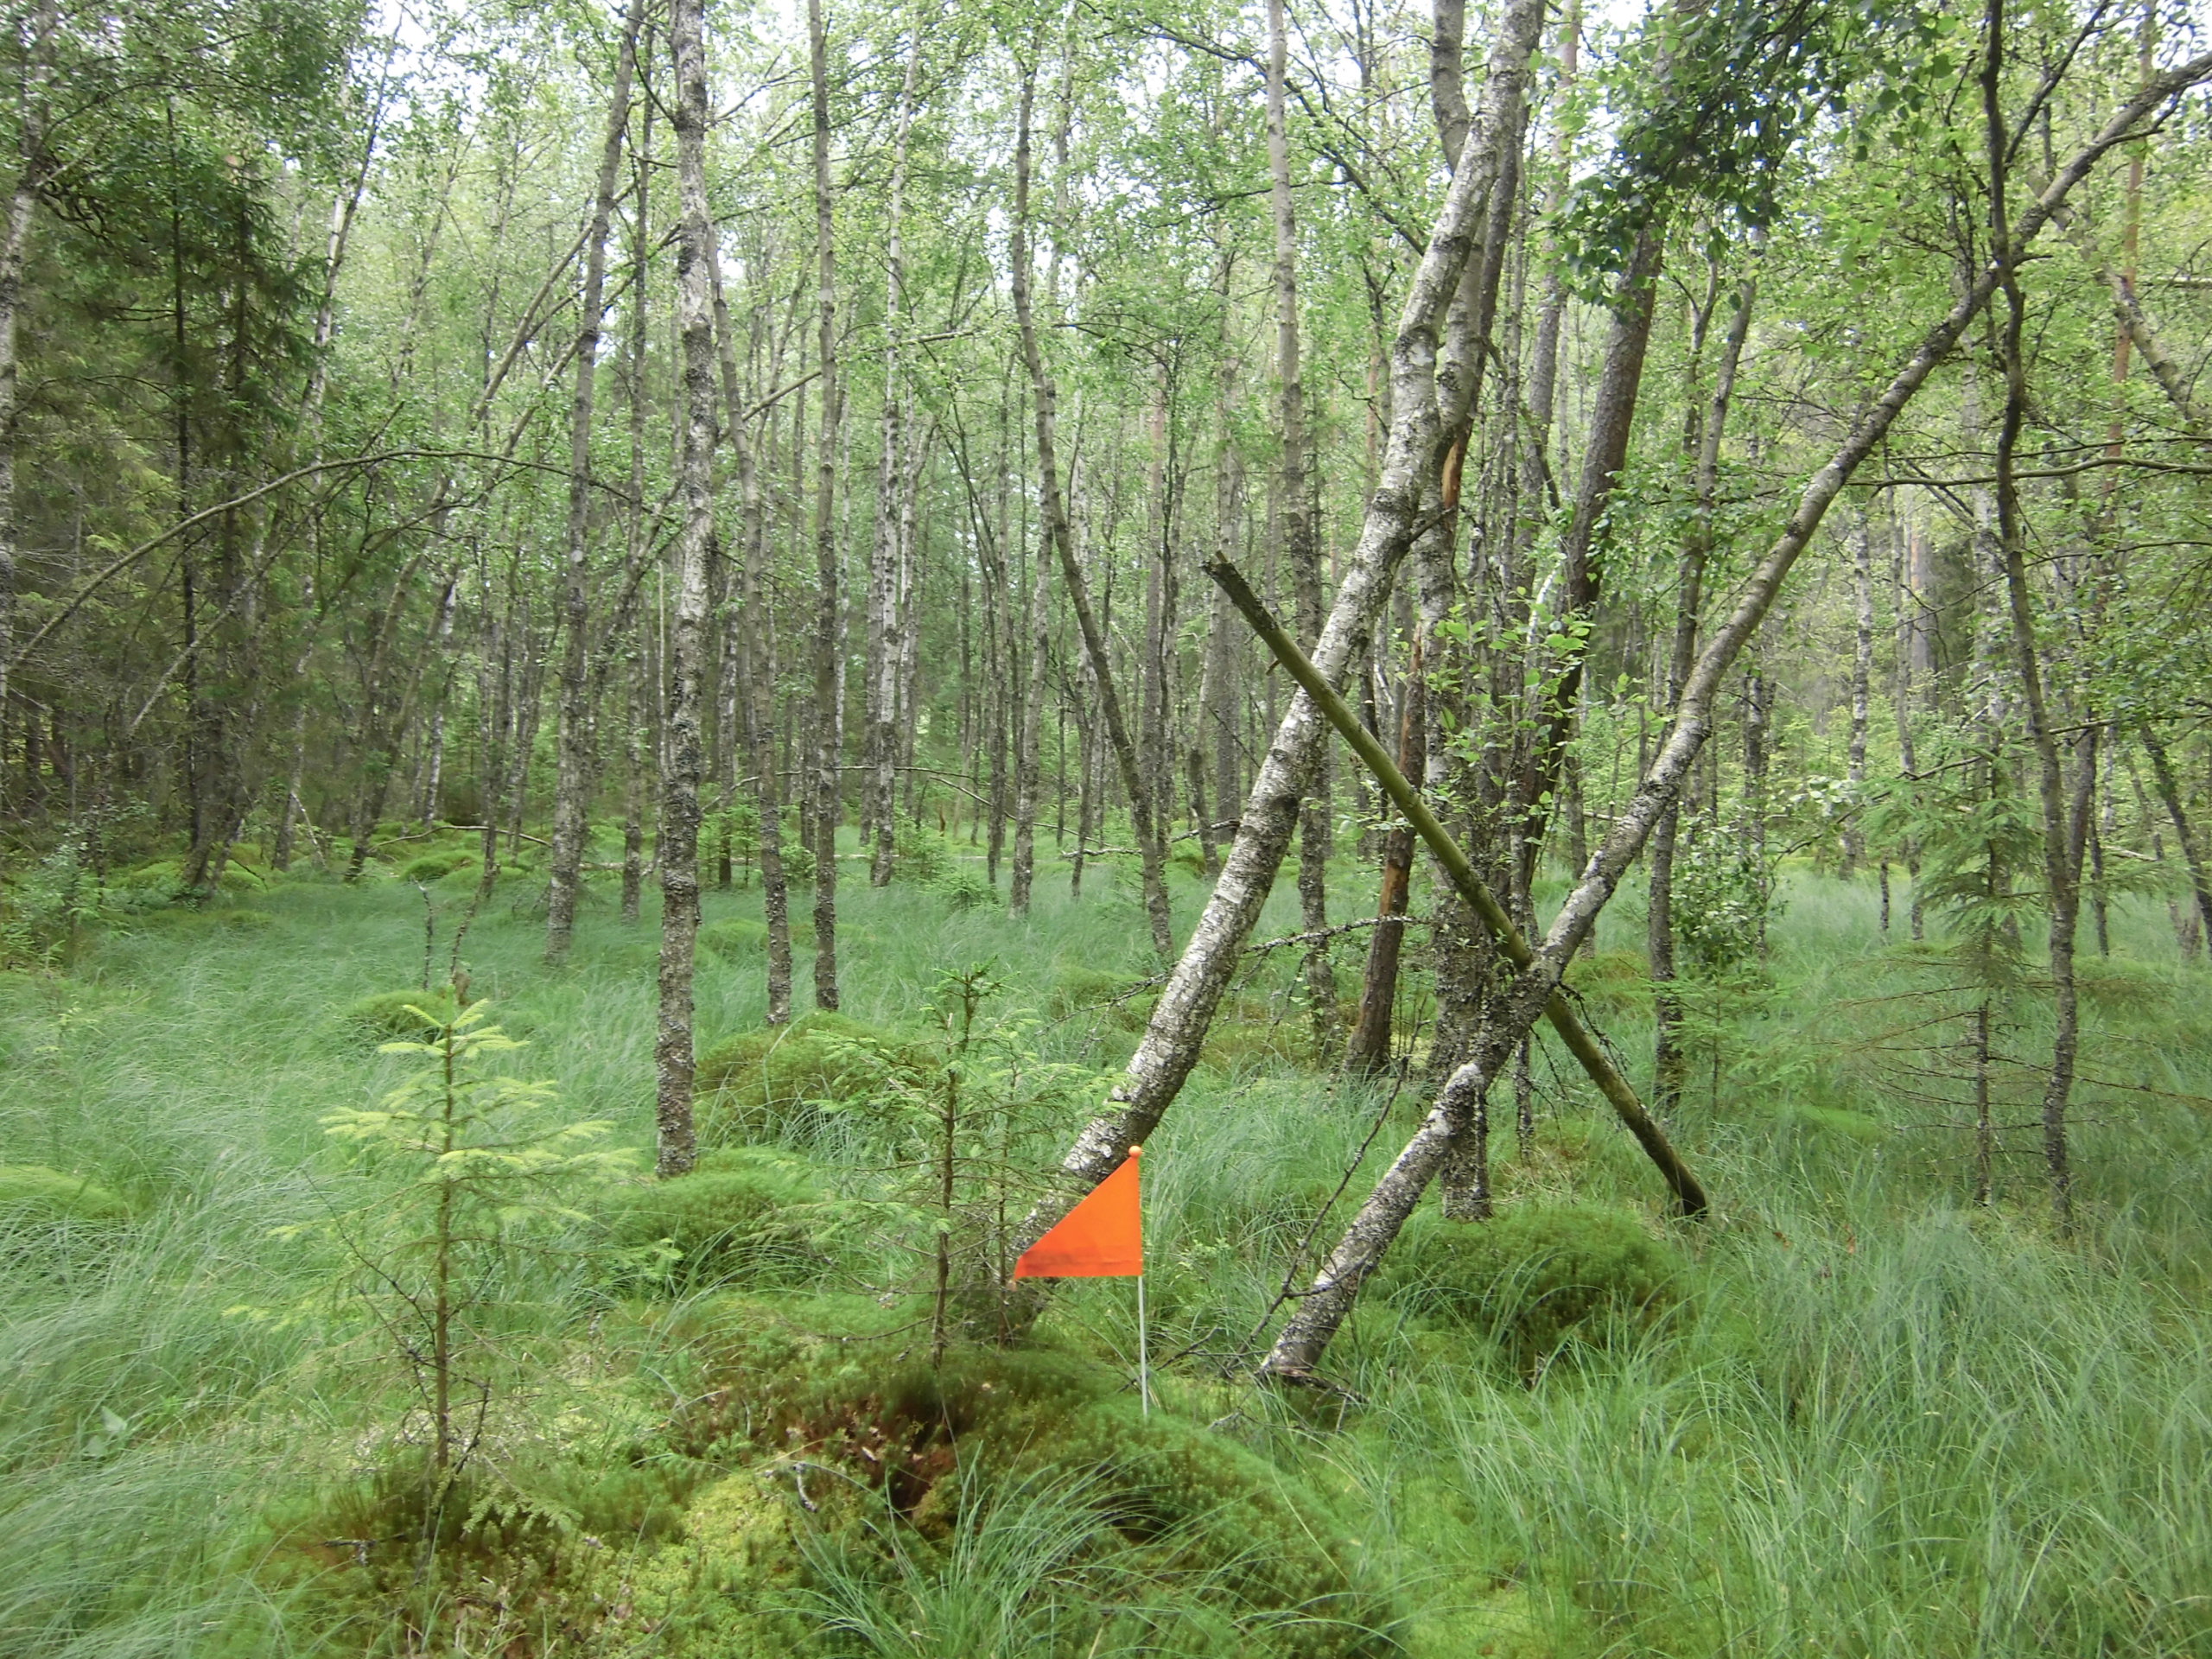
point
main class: Woodland
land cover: Broadleaved woodland
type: mire and swamp forests
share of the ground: 50 - 75 %
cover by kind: broadleaved forest trees 50 %, herbaceous plants 20 %, lichens and mosses 20 %, coniferous forest trees 5 %, shrubs 5 %
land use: Forestry
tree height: > 5 m
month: July
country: SE
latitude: 57.3590
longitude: 14.8003
